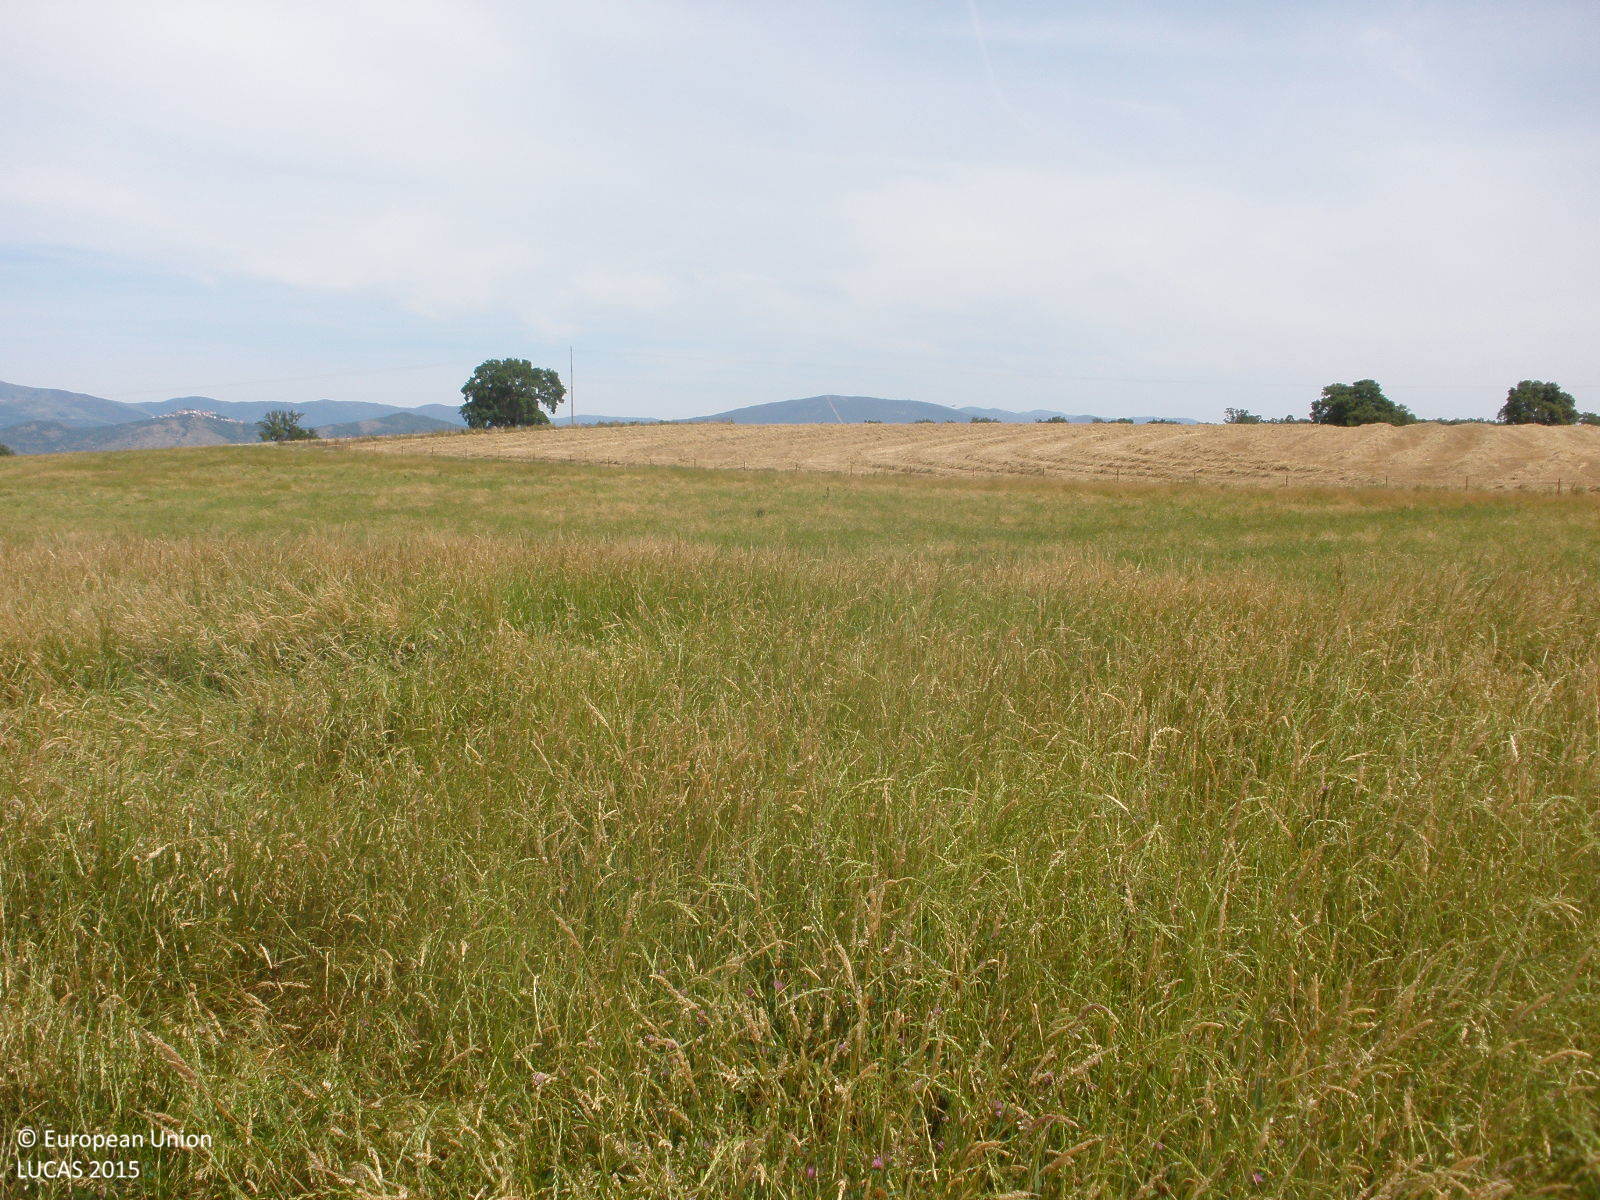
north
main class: Cropland
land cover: Mixed cereals for fodder
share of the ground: > 75 %
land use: Agriculture (excluding fallow land and kitchen gardens)
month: May
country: ES
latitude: 40.1049
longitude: -6.5410
